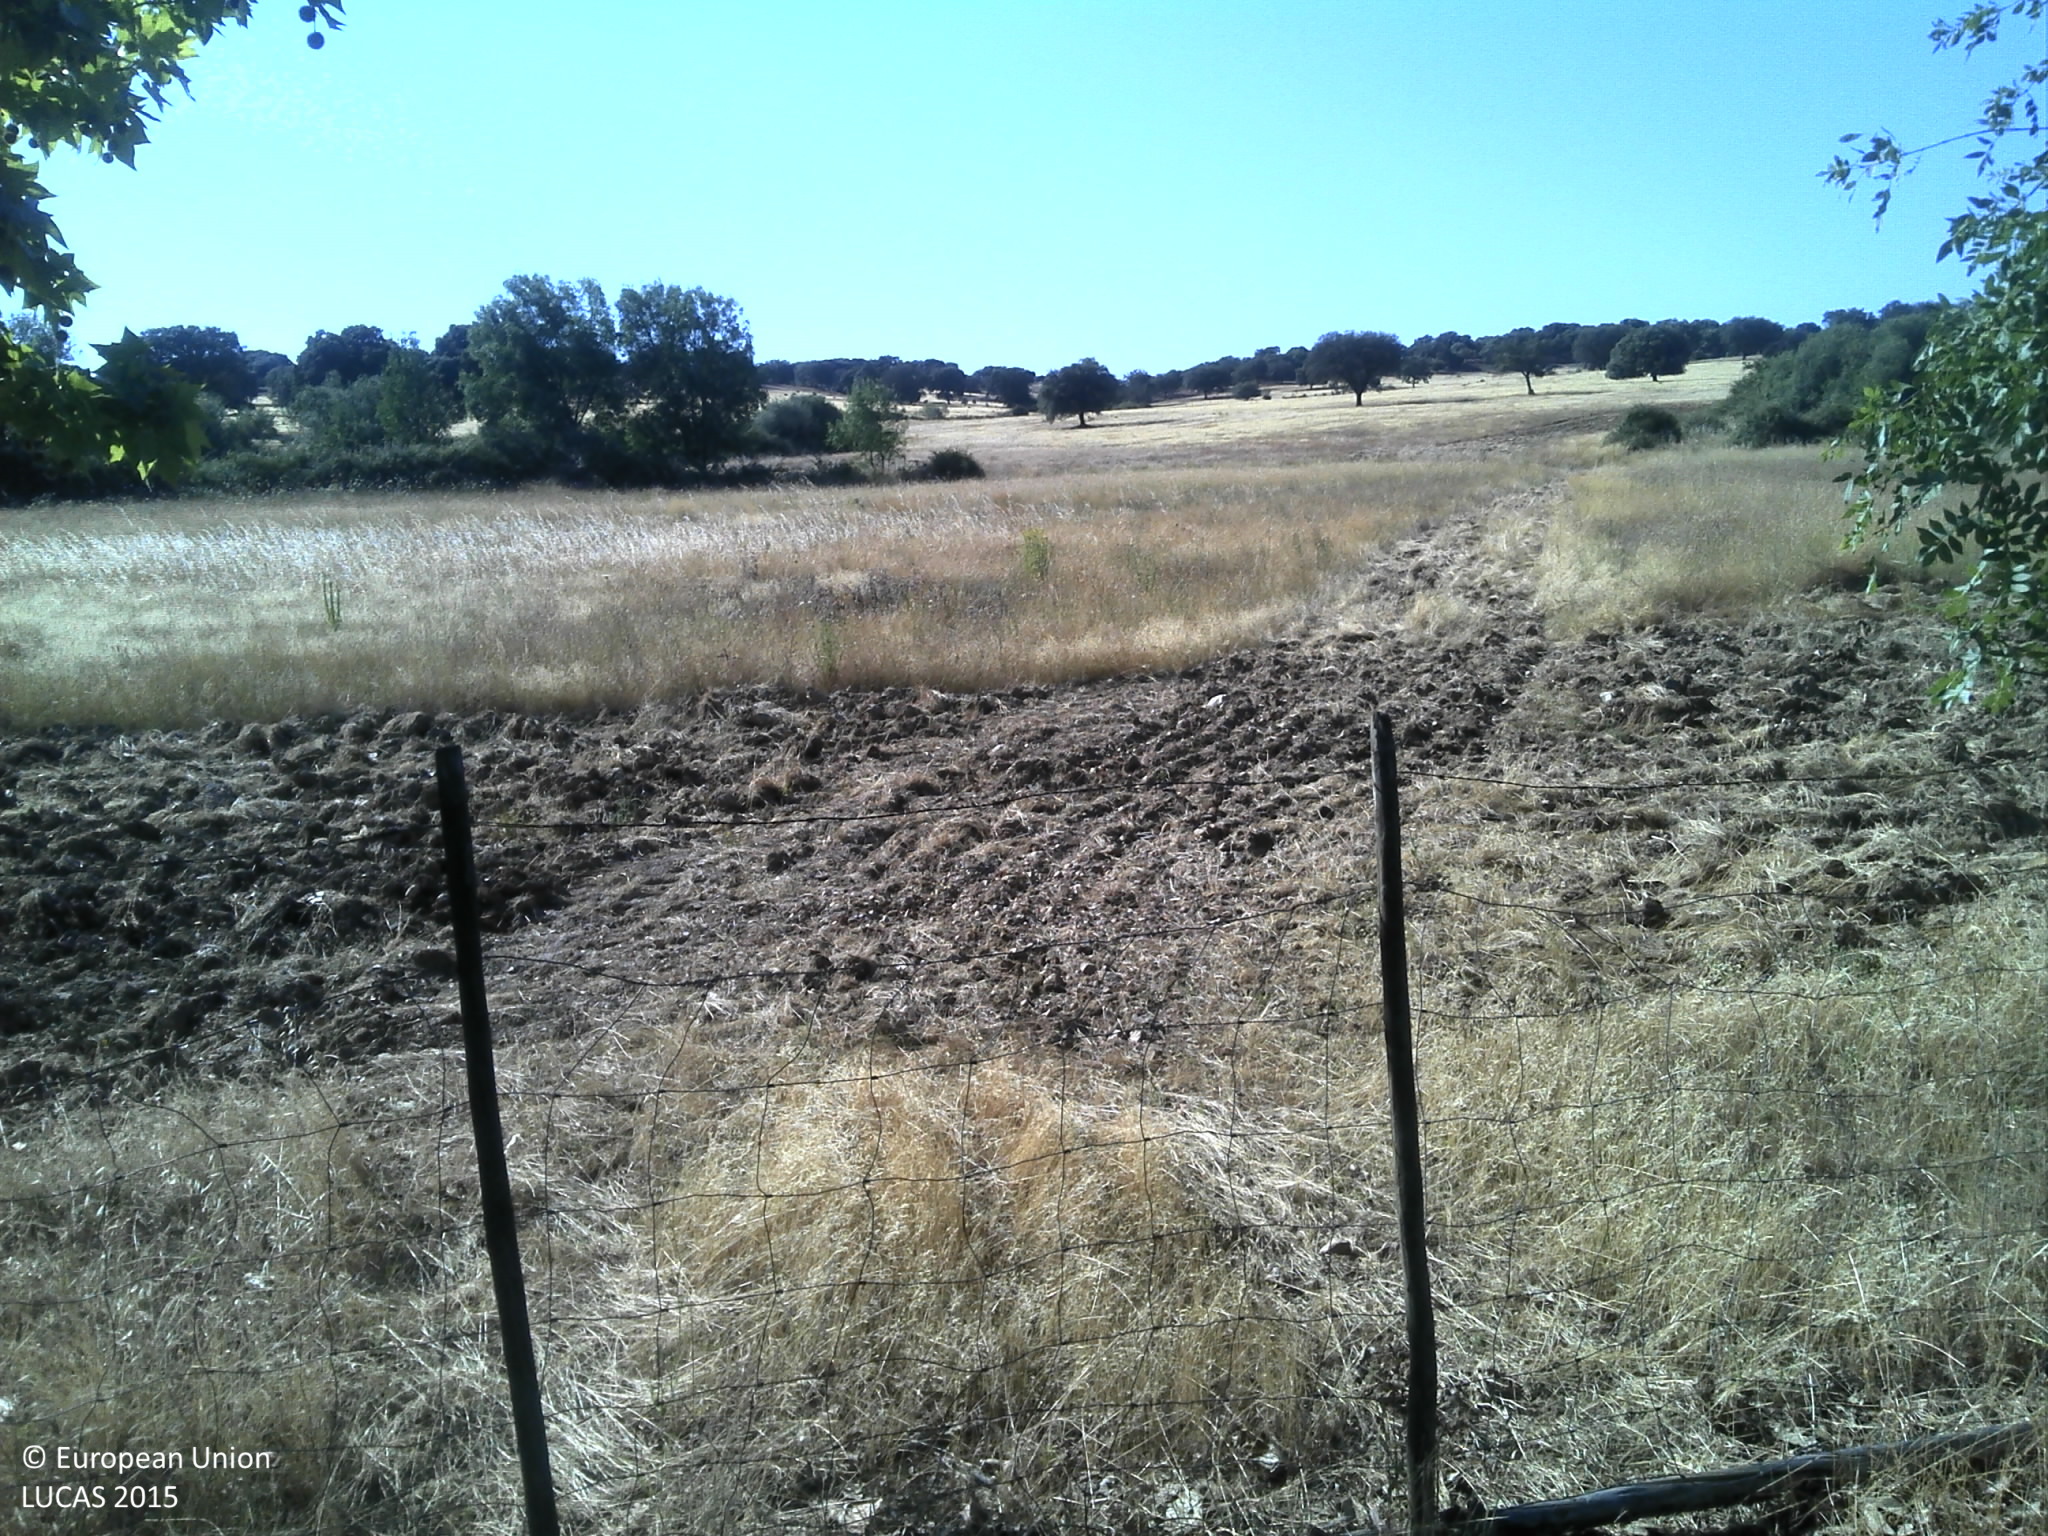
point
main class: Grassland
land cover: Grassland without tree/shrub cover
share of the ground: 50 - 75 %
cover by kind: herbaceous plants 70 %, unconsolidated bare surface 20 %
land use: Agriculture (excluding fallow land and kitchen gardens)
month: June
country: PT
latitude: 39.9442
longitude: -7.1452
